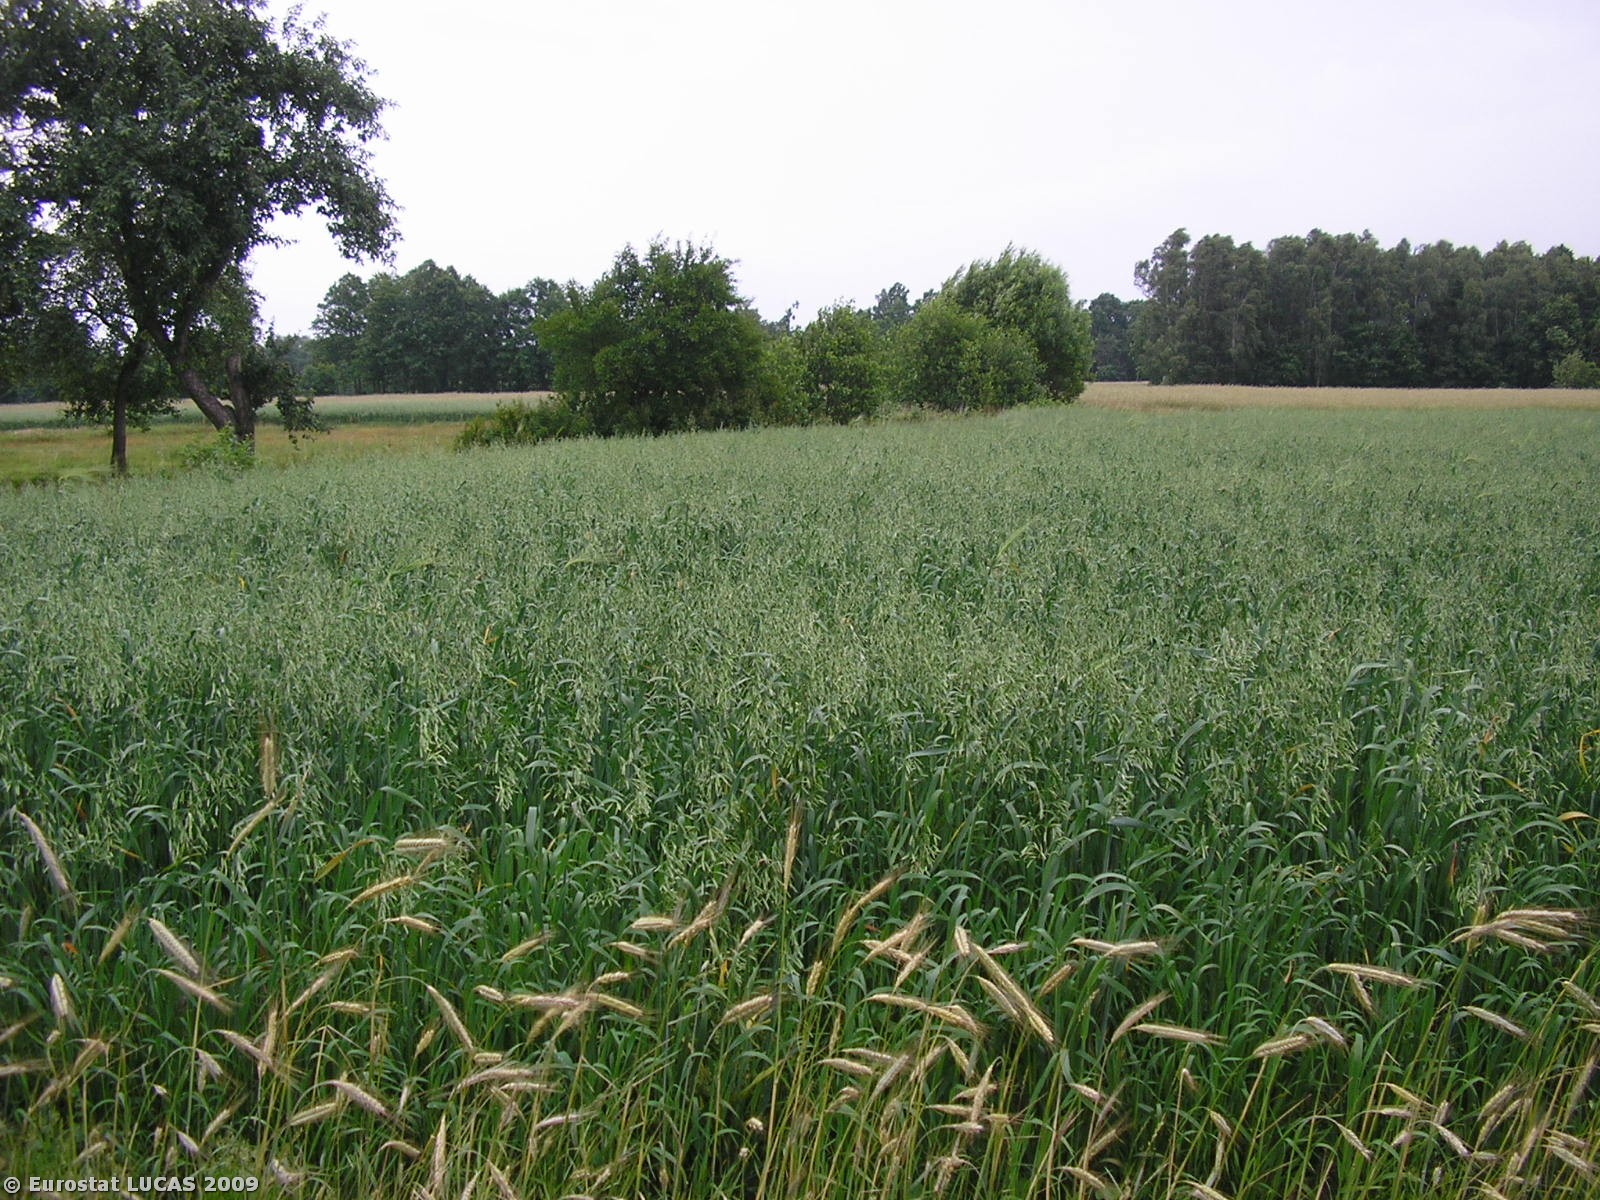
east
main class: Cropland
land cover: Rye
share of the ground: > 75 %
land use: Agriculture (excluding fallow land and kitchen gardens)
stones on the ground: < 10 %
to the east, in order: Rye; Oats; Grassland without tree/shrub cover; Rye; Grass margins; Rye; Oats; Tracks; Rye; Tracks; Grassland without tree/shrub cover; Rye
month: June
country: PL
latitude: 51.4661
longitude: 18.3819
